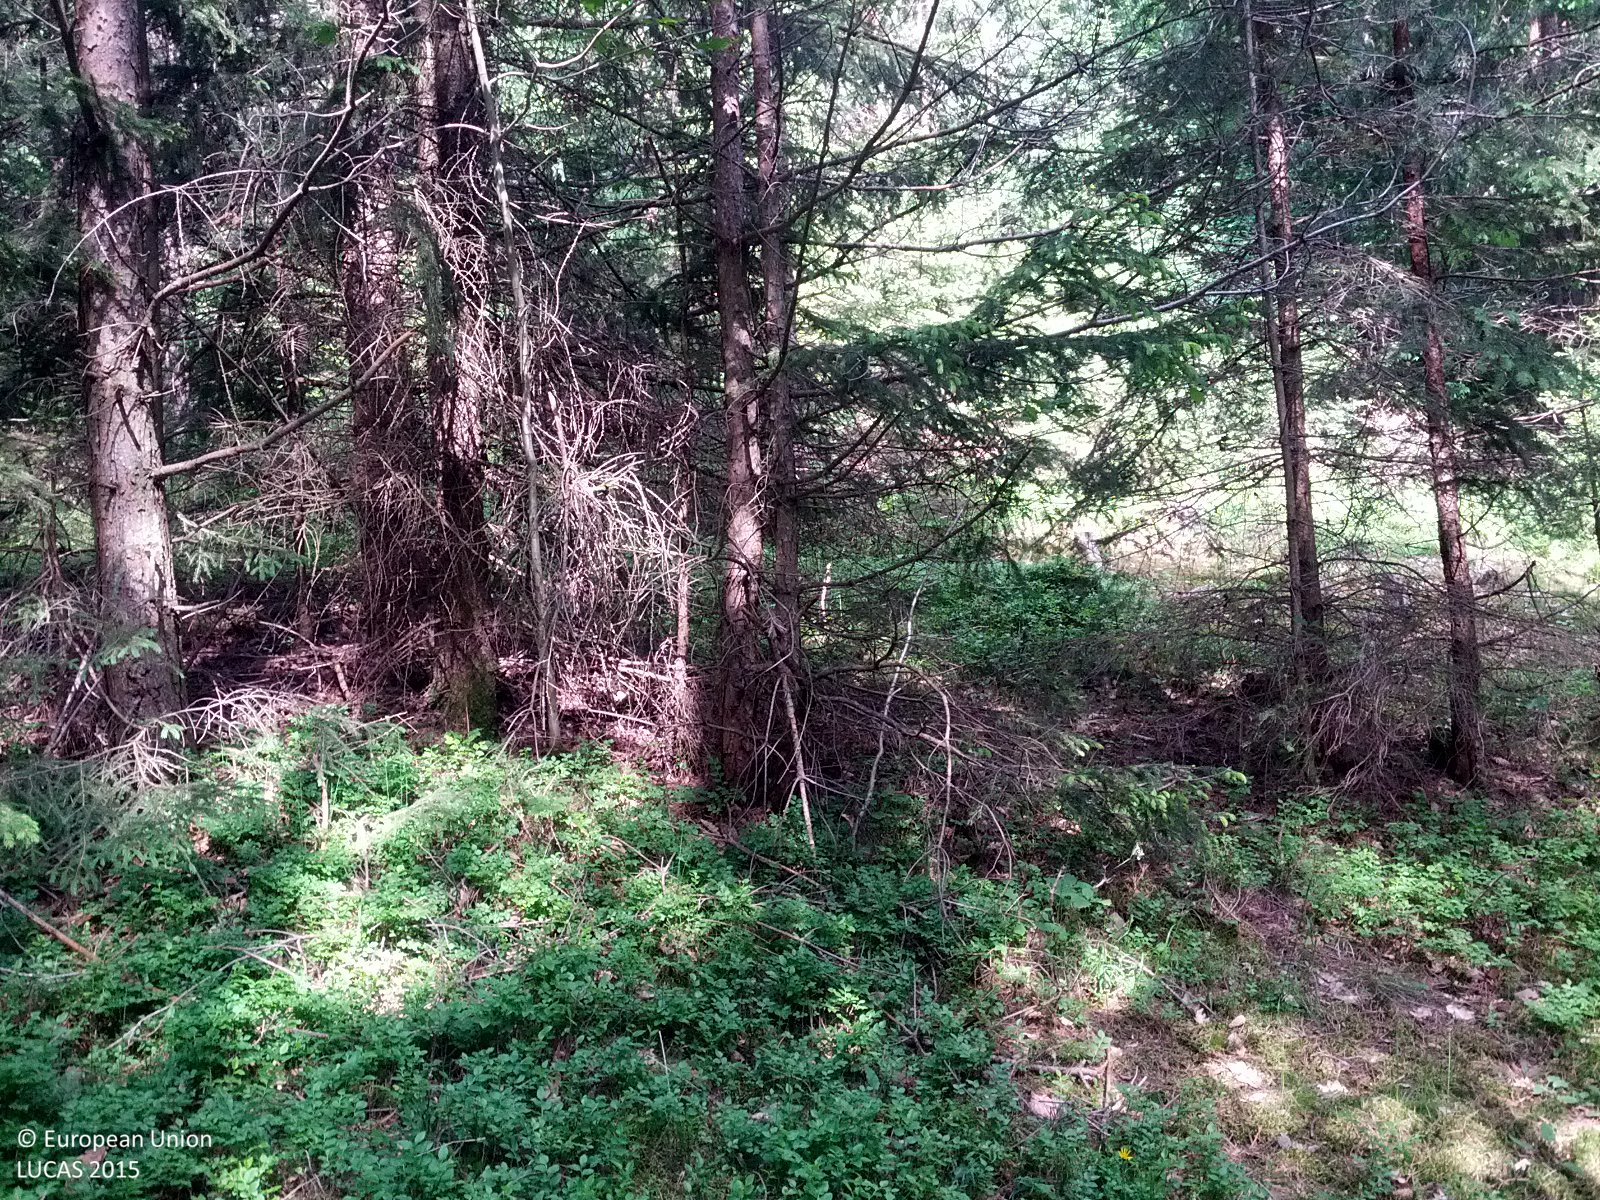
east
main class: Woodland
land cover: Pine dominated mixed woodland
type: boreal forest
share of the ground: > 75 %
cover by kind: coniferous forest trees 50 %, broadleaved forest trees 25 %, shrubs 20 %, herbaceous plants 5 %
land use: Forestry
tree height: > 5 m
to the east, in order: Pine dominated mixed woodland; Tracks; Pine dominated mixed woodland; Tracks; Pine dominated mixed woodland; Tracks; Pine dominated mixed woodland; Tracks; Pine dominated mixed woodland; Spruce dominated mixed woodland
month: May
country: AT
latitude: 47.4013
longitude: 16.1639
